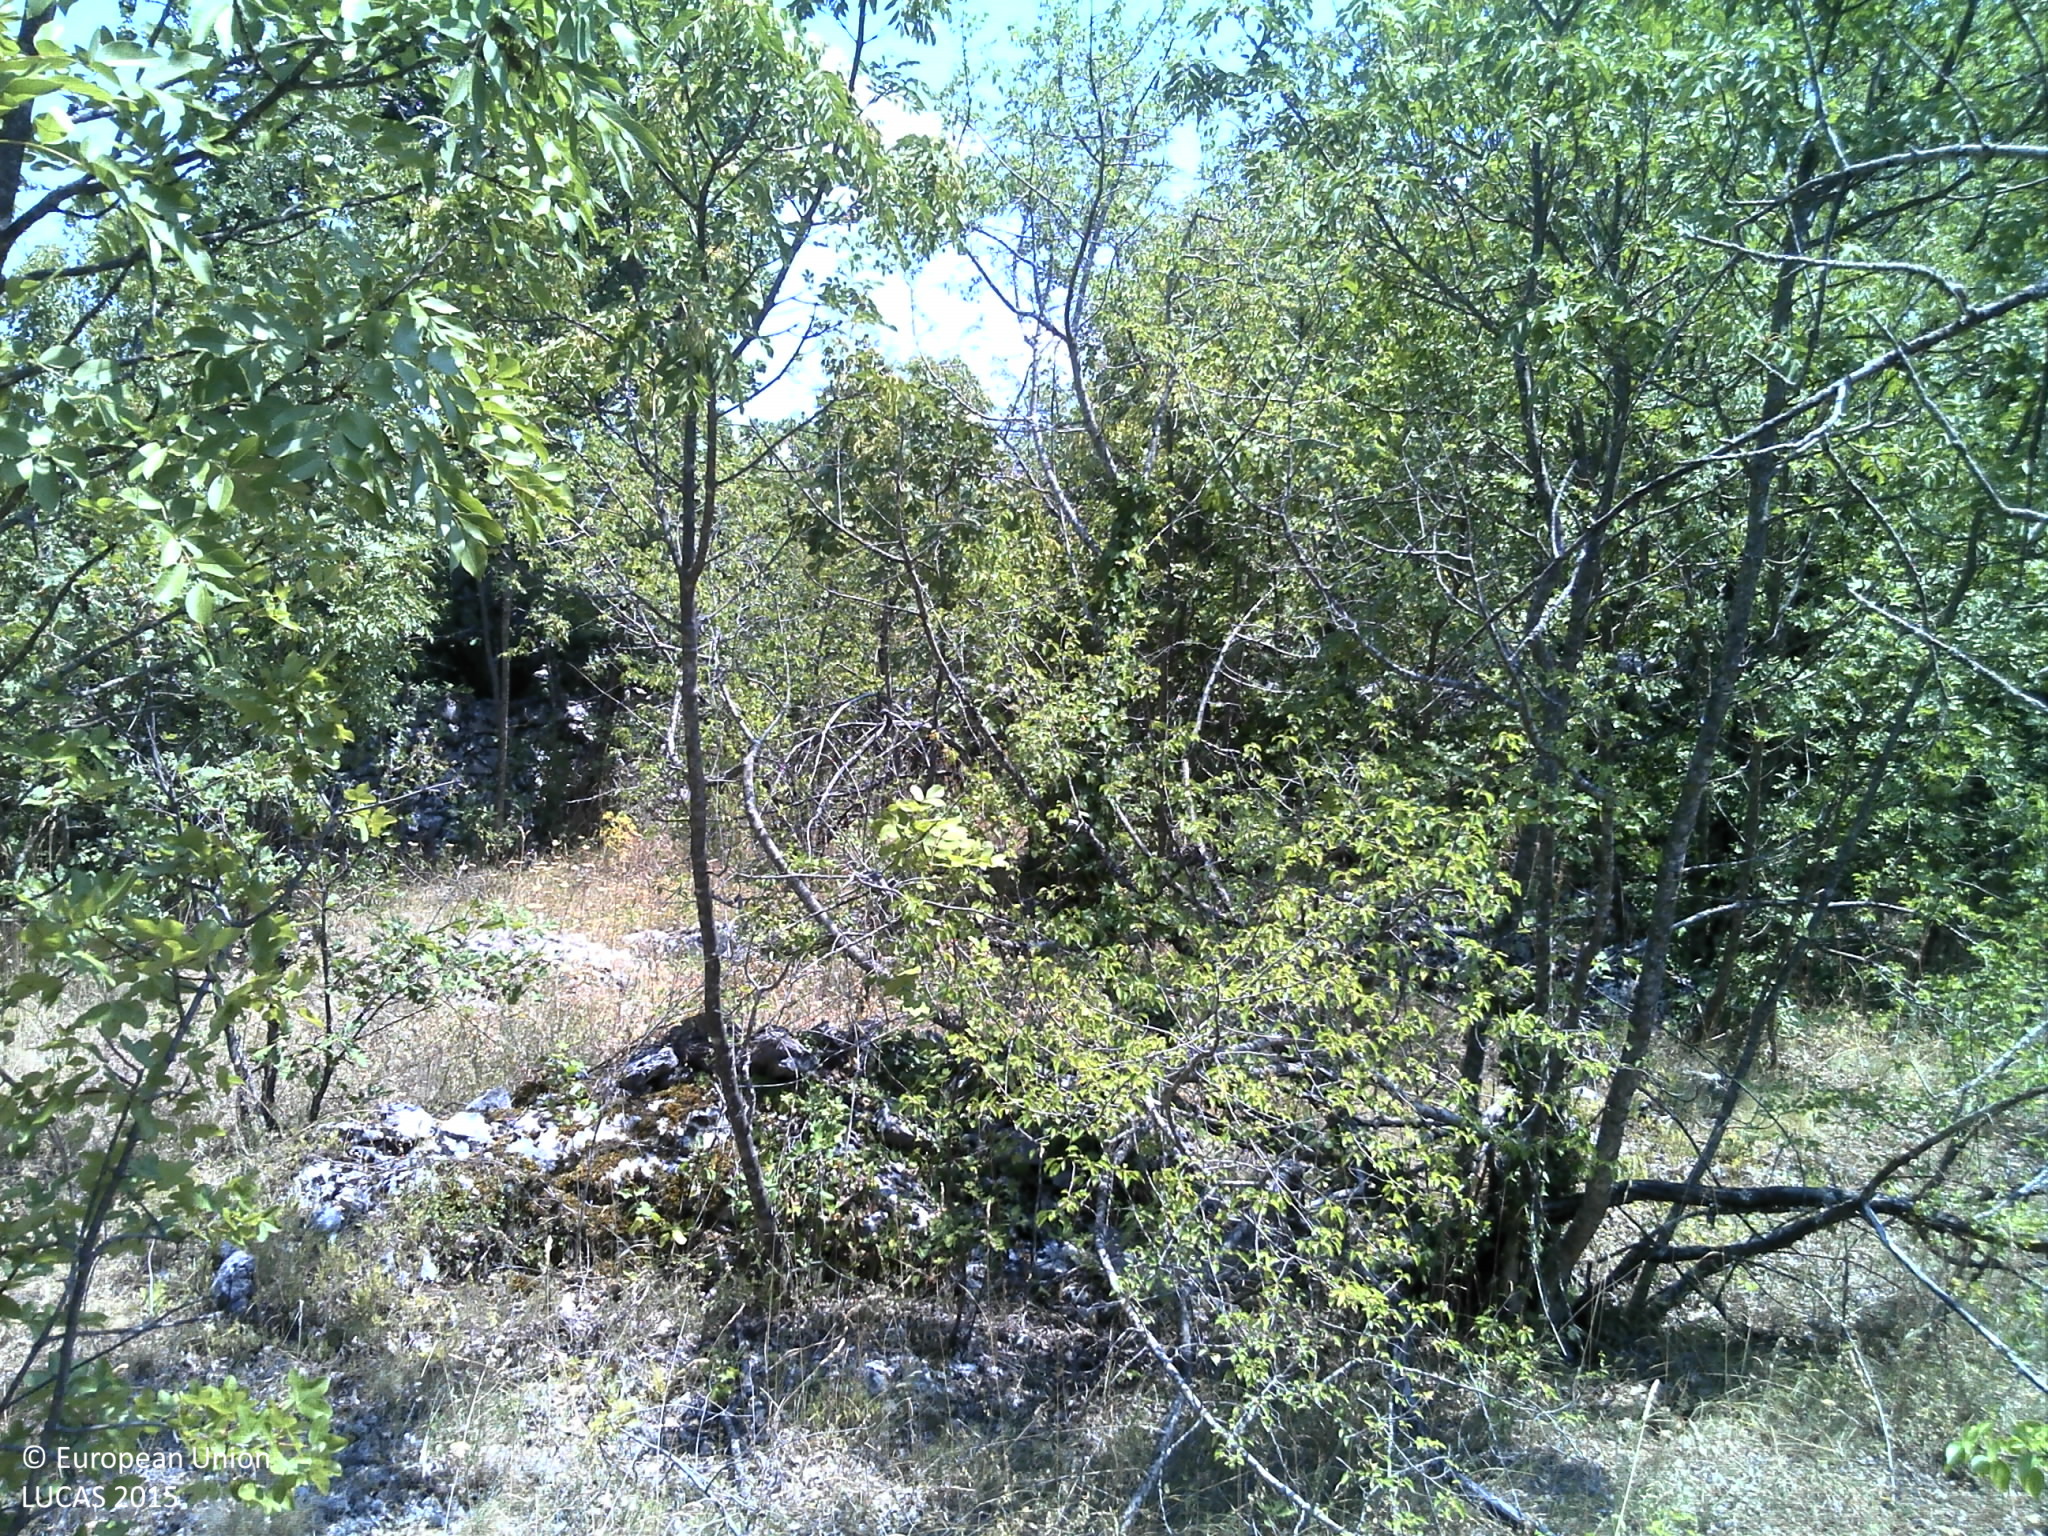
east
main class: Shrubland
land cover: Shrubland with sparse tree cover
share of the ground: > 75 %
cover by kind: shrubs 60 %, herbaceous plants 15 %, unconsolidated bare surface 15 %, broadleaved forest trees 5 %, consolidated bare surface 5 %
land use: Semi-natural and natural areas not in use
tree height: > 5 m
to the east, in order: Shrubland with sparse tree cover; Dry stone walls; Shrubland with sparse tree cover; Grassland with sparse tree/shrub cover; Dry stone walls; Grassland with sparse tree/shrub cover; Shrubland with sparse tree cover; Dry stone walls; Grassland with sparse tree/shrub cover; Rocks and stones; Dry stone walls; Grassland with sparse tree/shrub cover; Shrubland with sparse tree cover
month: July
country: HR
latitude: 43.4820
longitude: 16.9771
